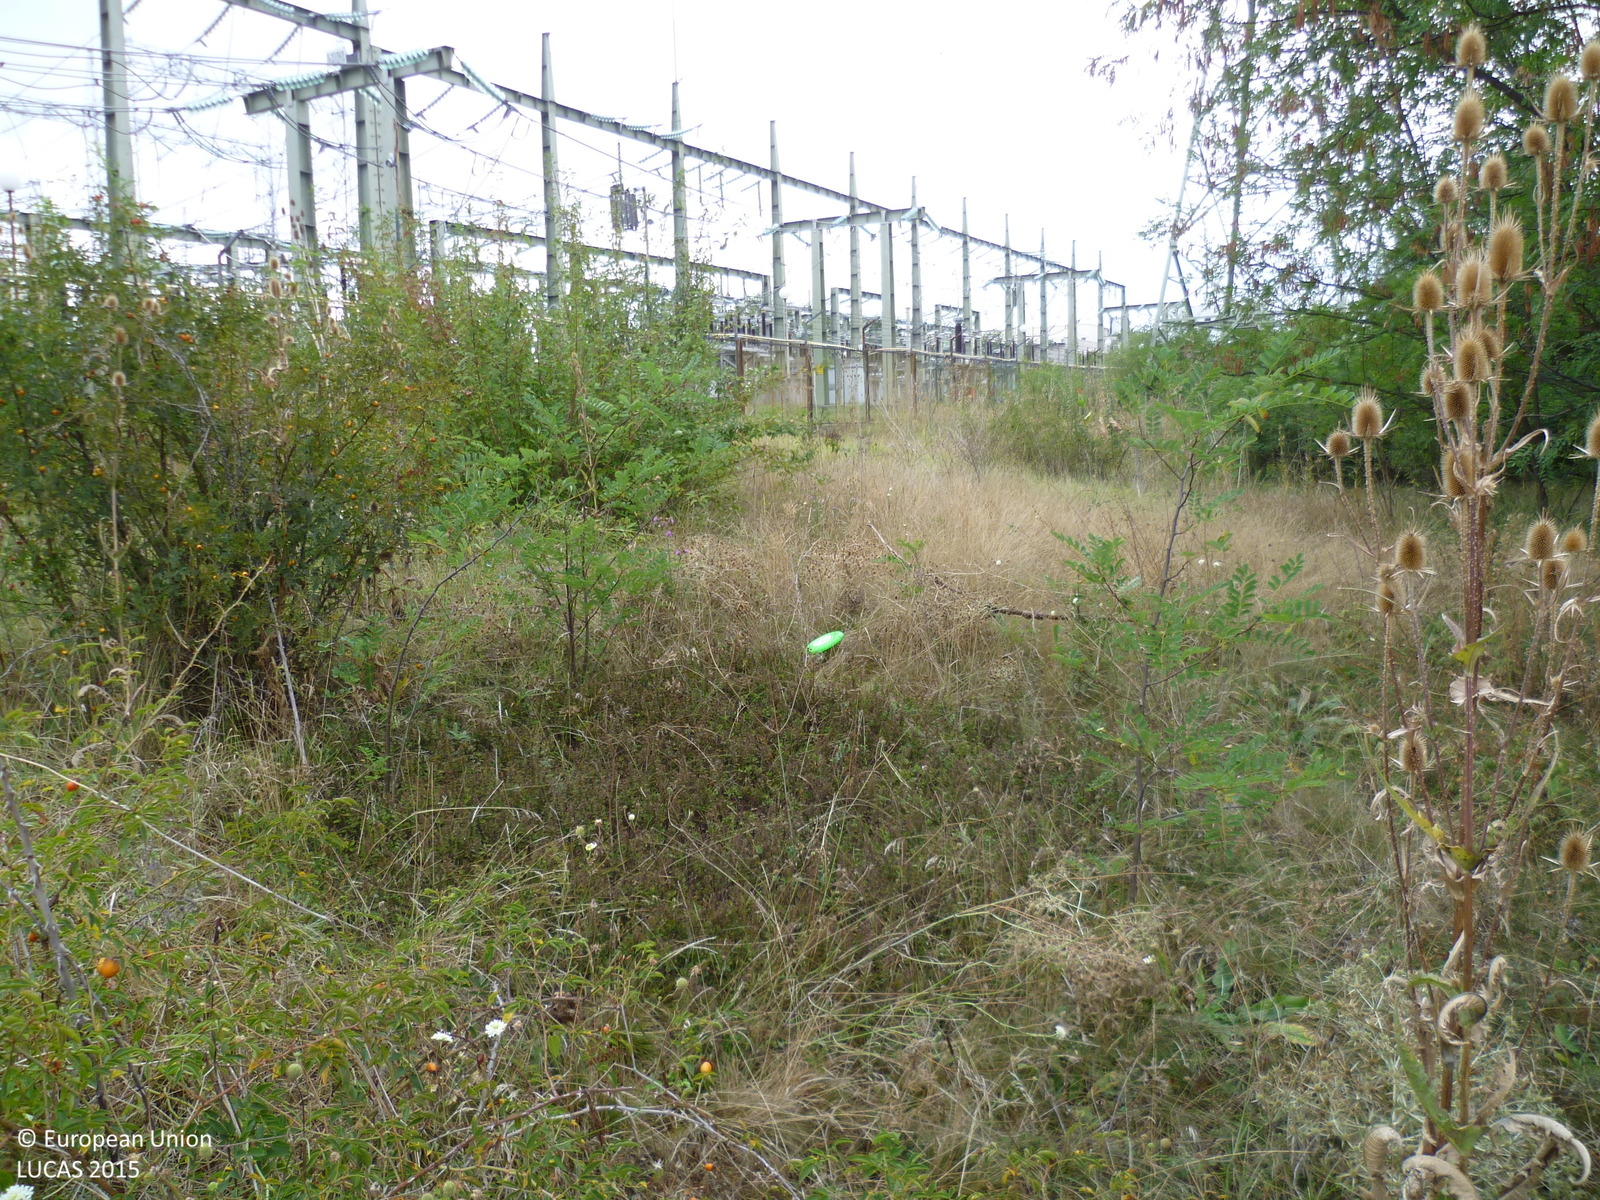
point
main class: Grassland
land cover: Grassland with sparse tree/shrub cover
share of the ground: > 75 %
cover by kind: herbaceous plants 85 %, shrubs 10 %, broadleaved forest trees 5 %
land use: Fallow land
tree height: > 5 m
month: September
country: BG
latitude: 42.8472
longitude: 23.1880
